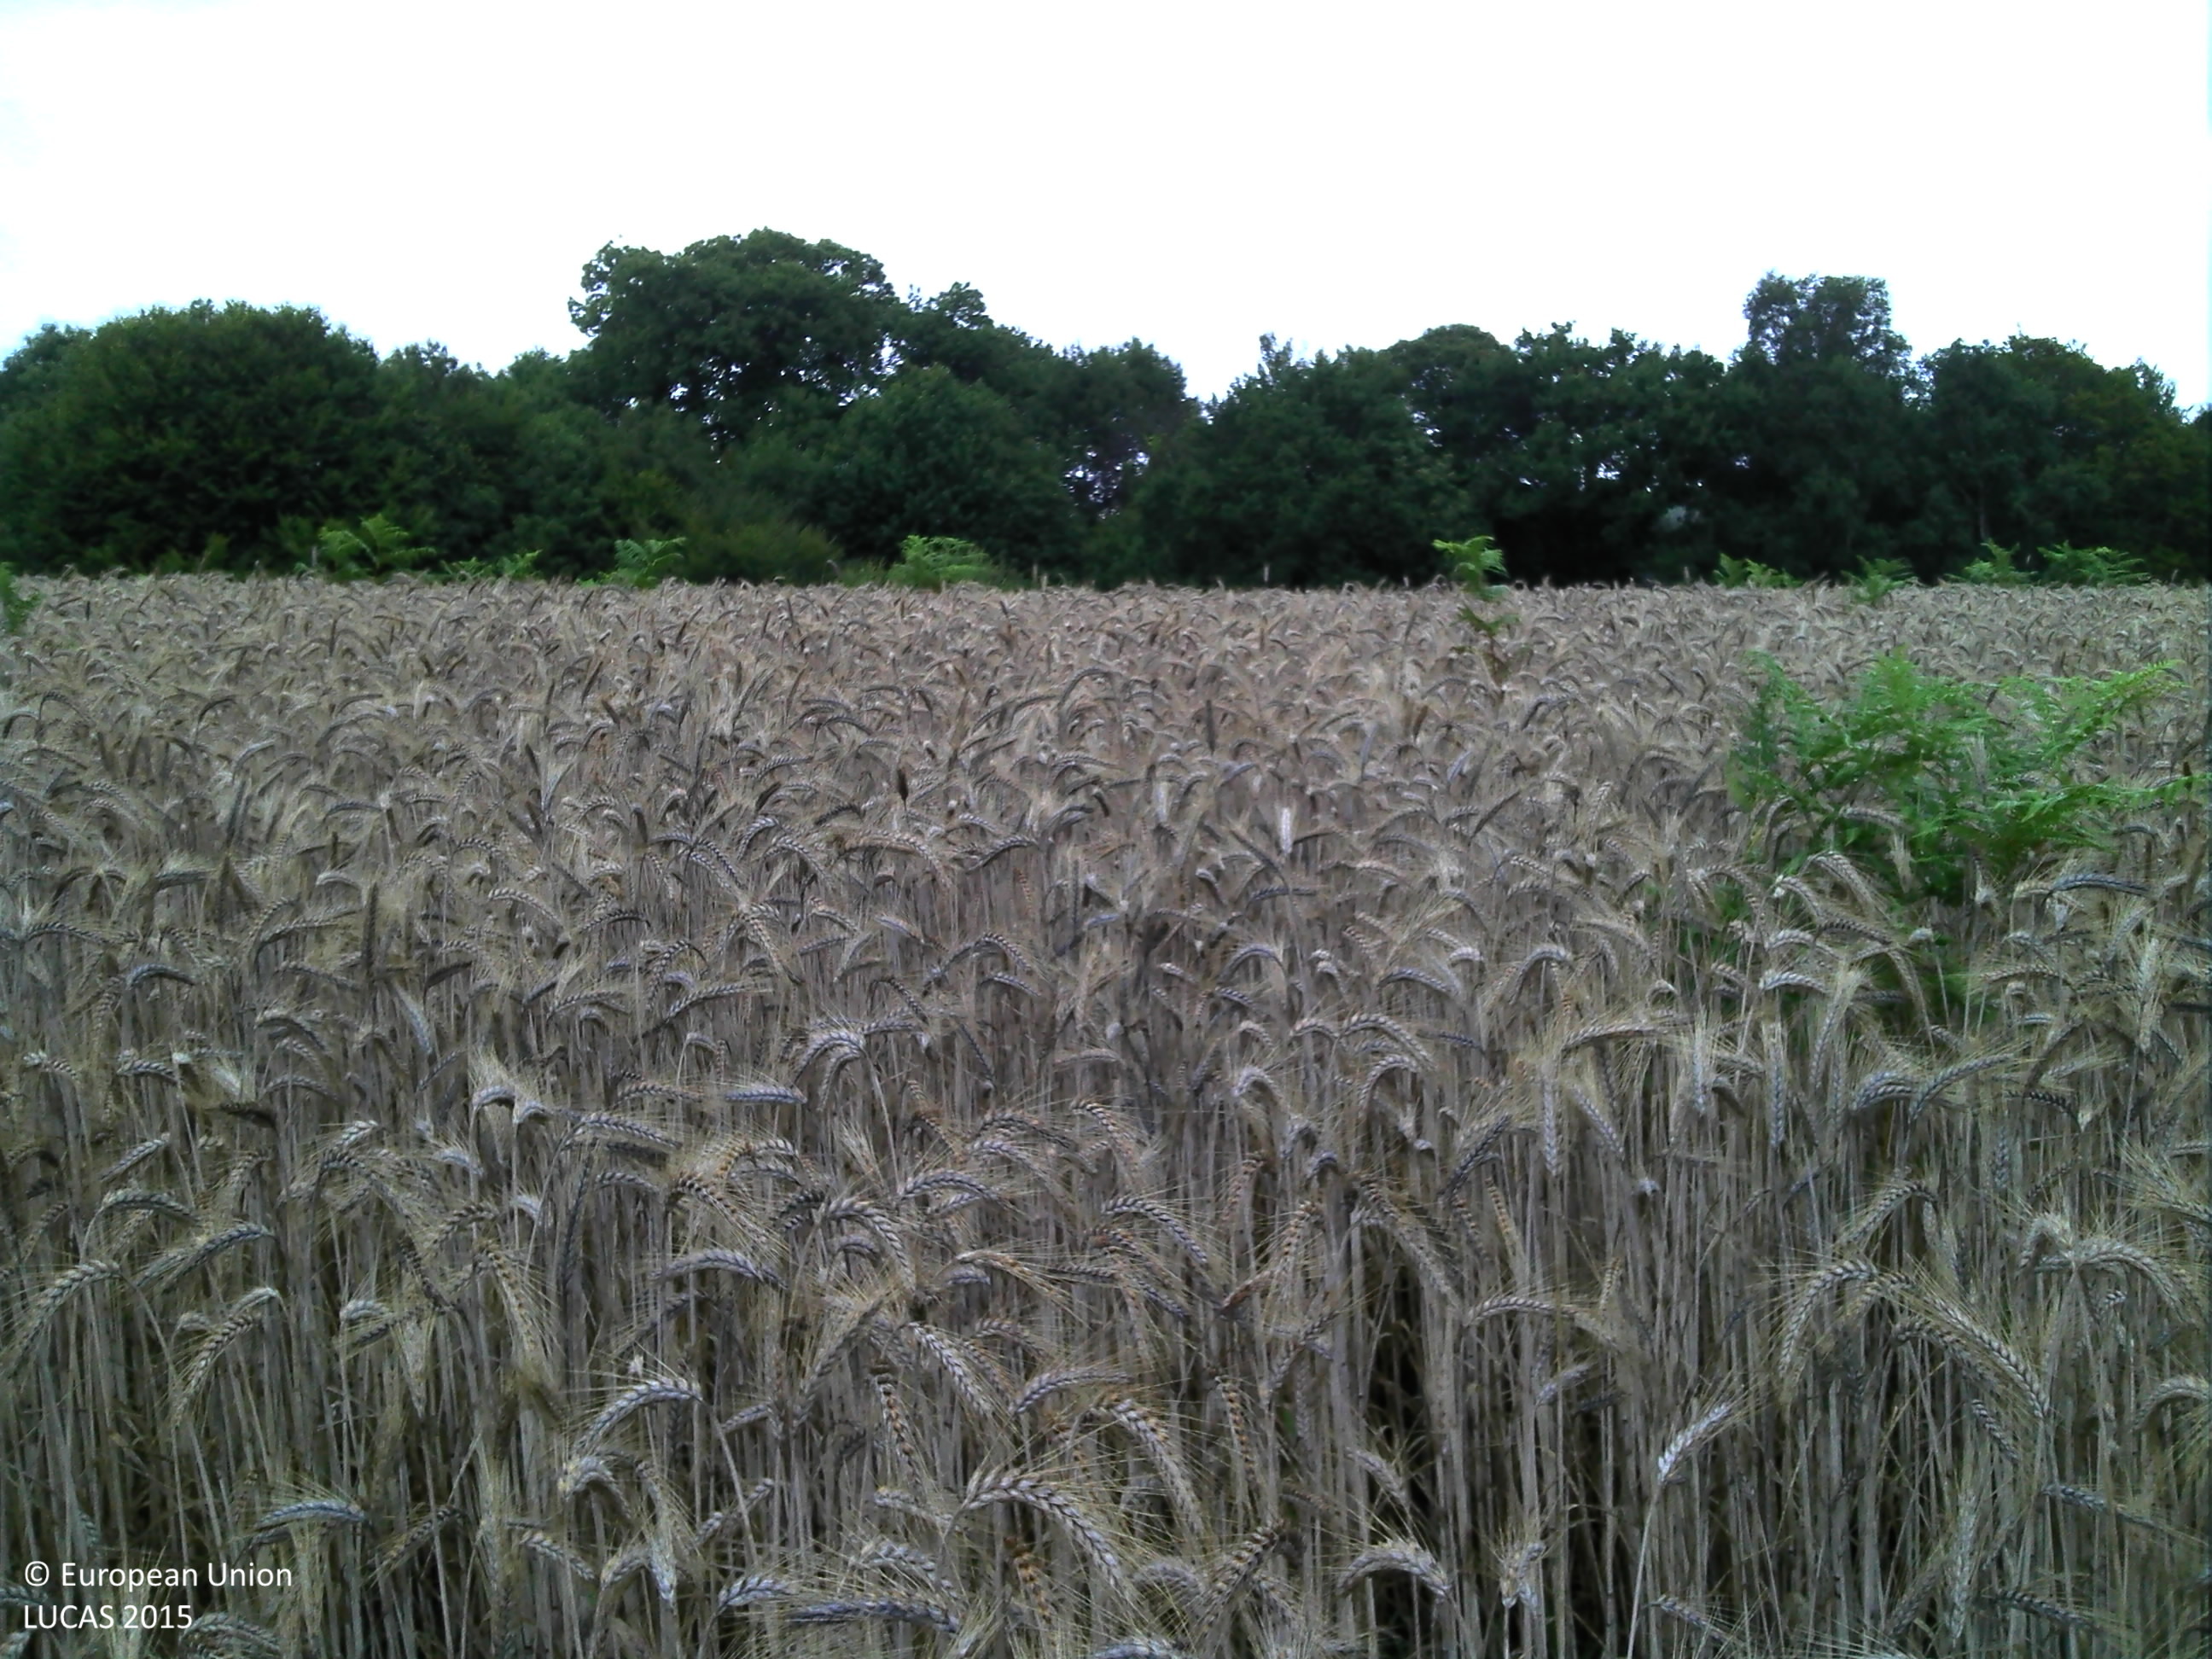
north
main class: Cropland
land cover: Common wheat
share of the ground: > 75 %
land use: Agriculture (excluding fallow land and kitchen gardens)
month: July
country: FR
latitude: 47.9883
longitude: -3.5166
